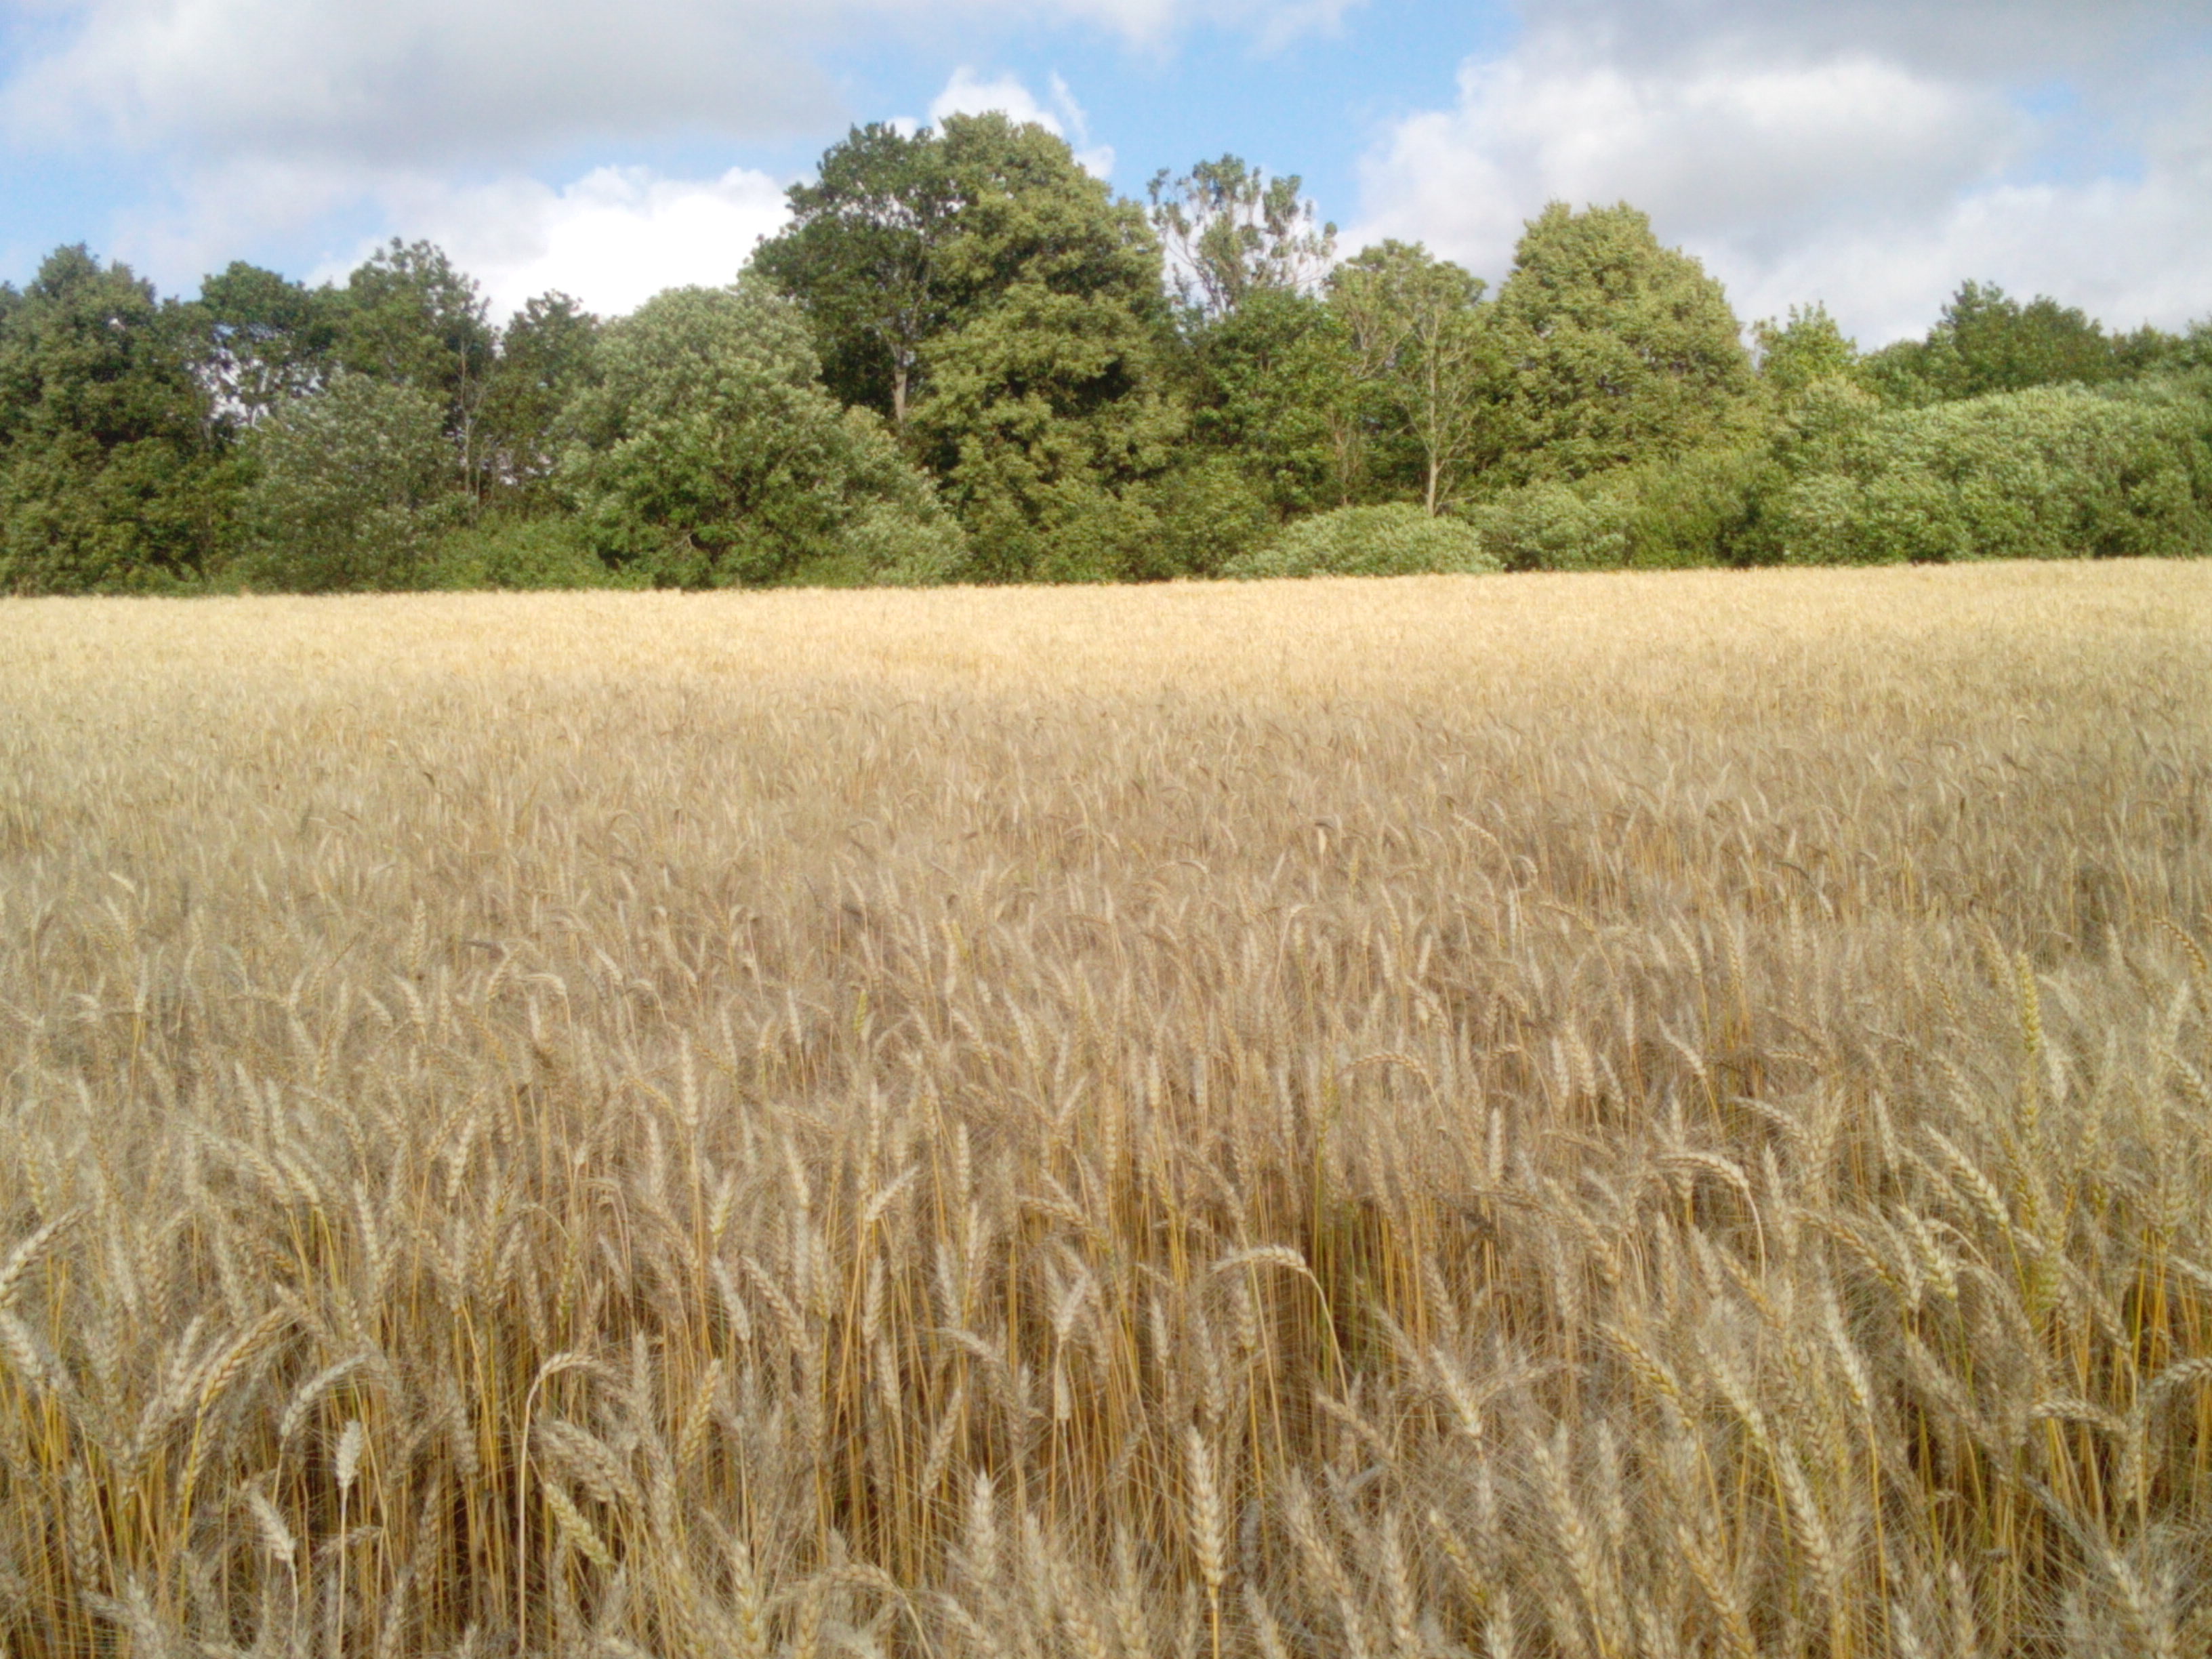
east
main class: Cropland
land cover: Common wheat
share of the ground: > 75 %
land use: Agriculture (excluding fallow land and kitchen gardens)
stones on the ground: 10 - 25 %
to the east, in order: Common wheat; Grassland without tree/shrub cover; Broadleaved woodland; Artificial constructions in urban areas; Broadleaved woodland; Grassland without tree/shrub cover; Potatoes
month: July
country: LV
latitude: 56.6494
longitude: 21.3090
